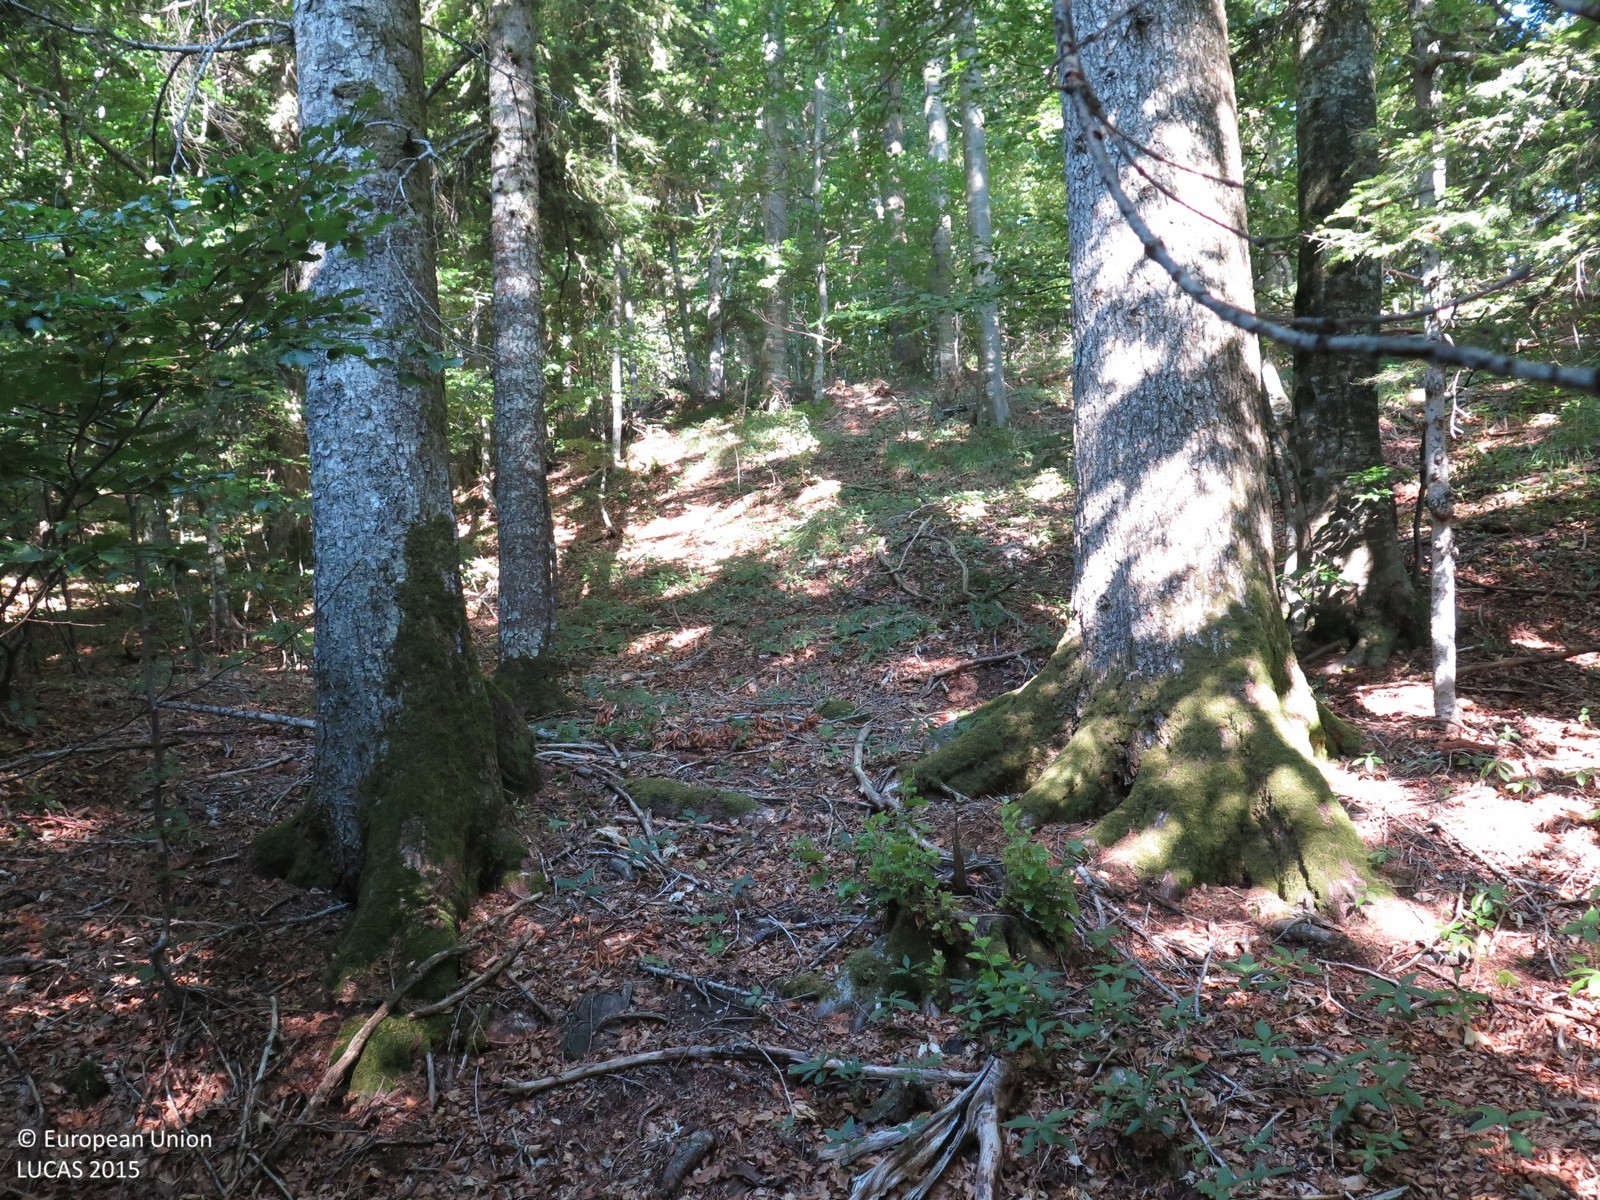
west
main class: Woodland
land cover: Broadleaved woodland
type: beech forest
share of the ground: > 75 %
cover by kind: broadleaved forest trees 95 %, herbaceous plants 5 %
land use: Forestry
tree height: > 5 m
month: August
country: HR
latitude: 45.2329
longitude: 14.7969
